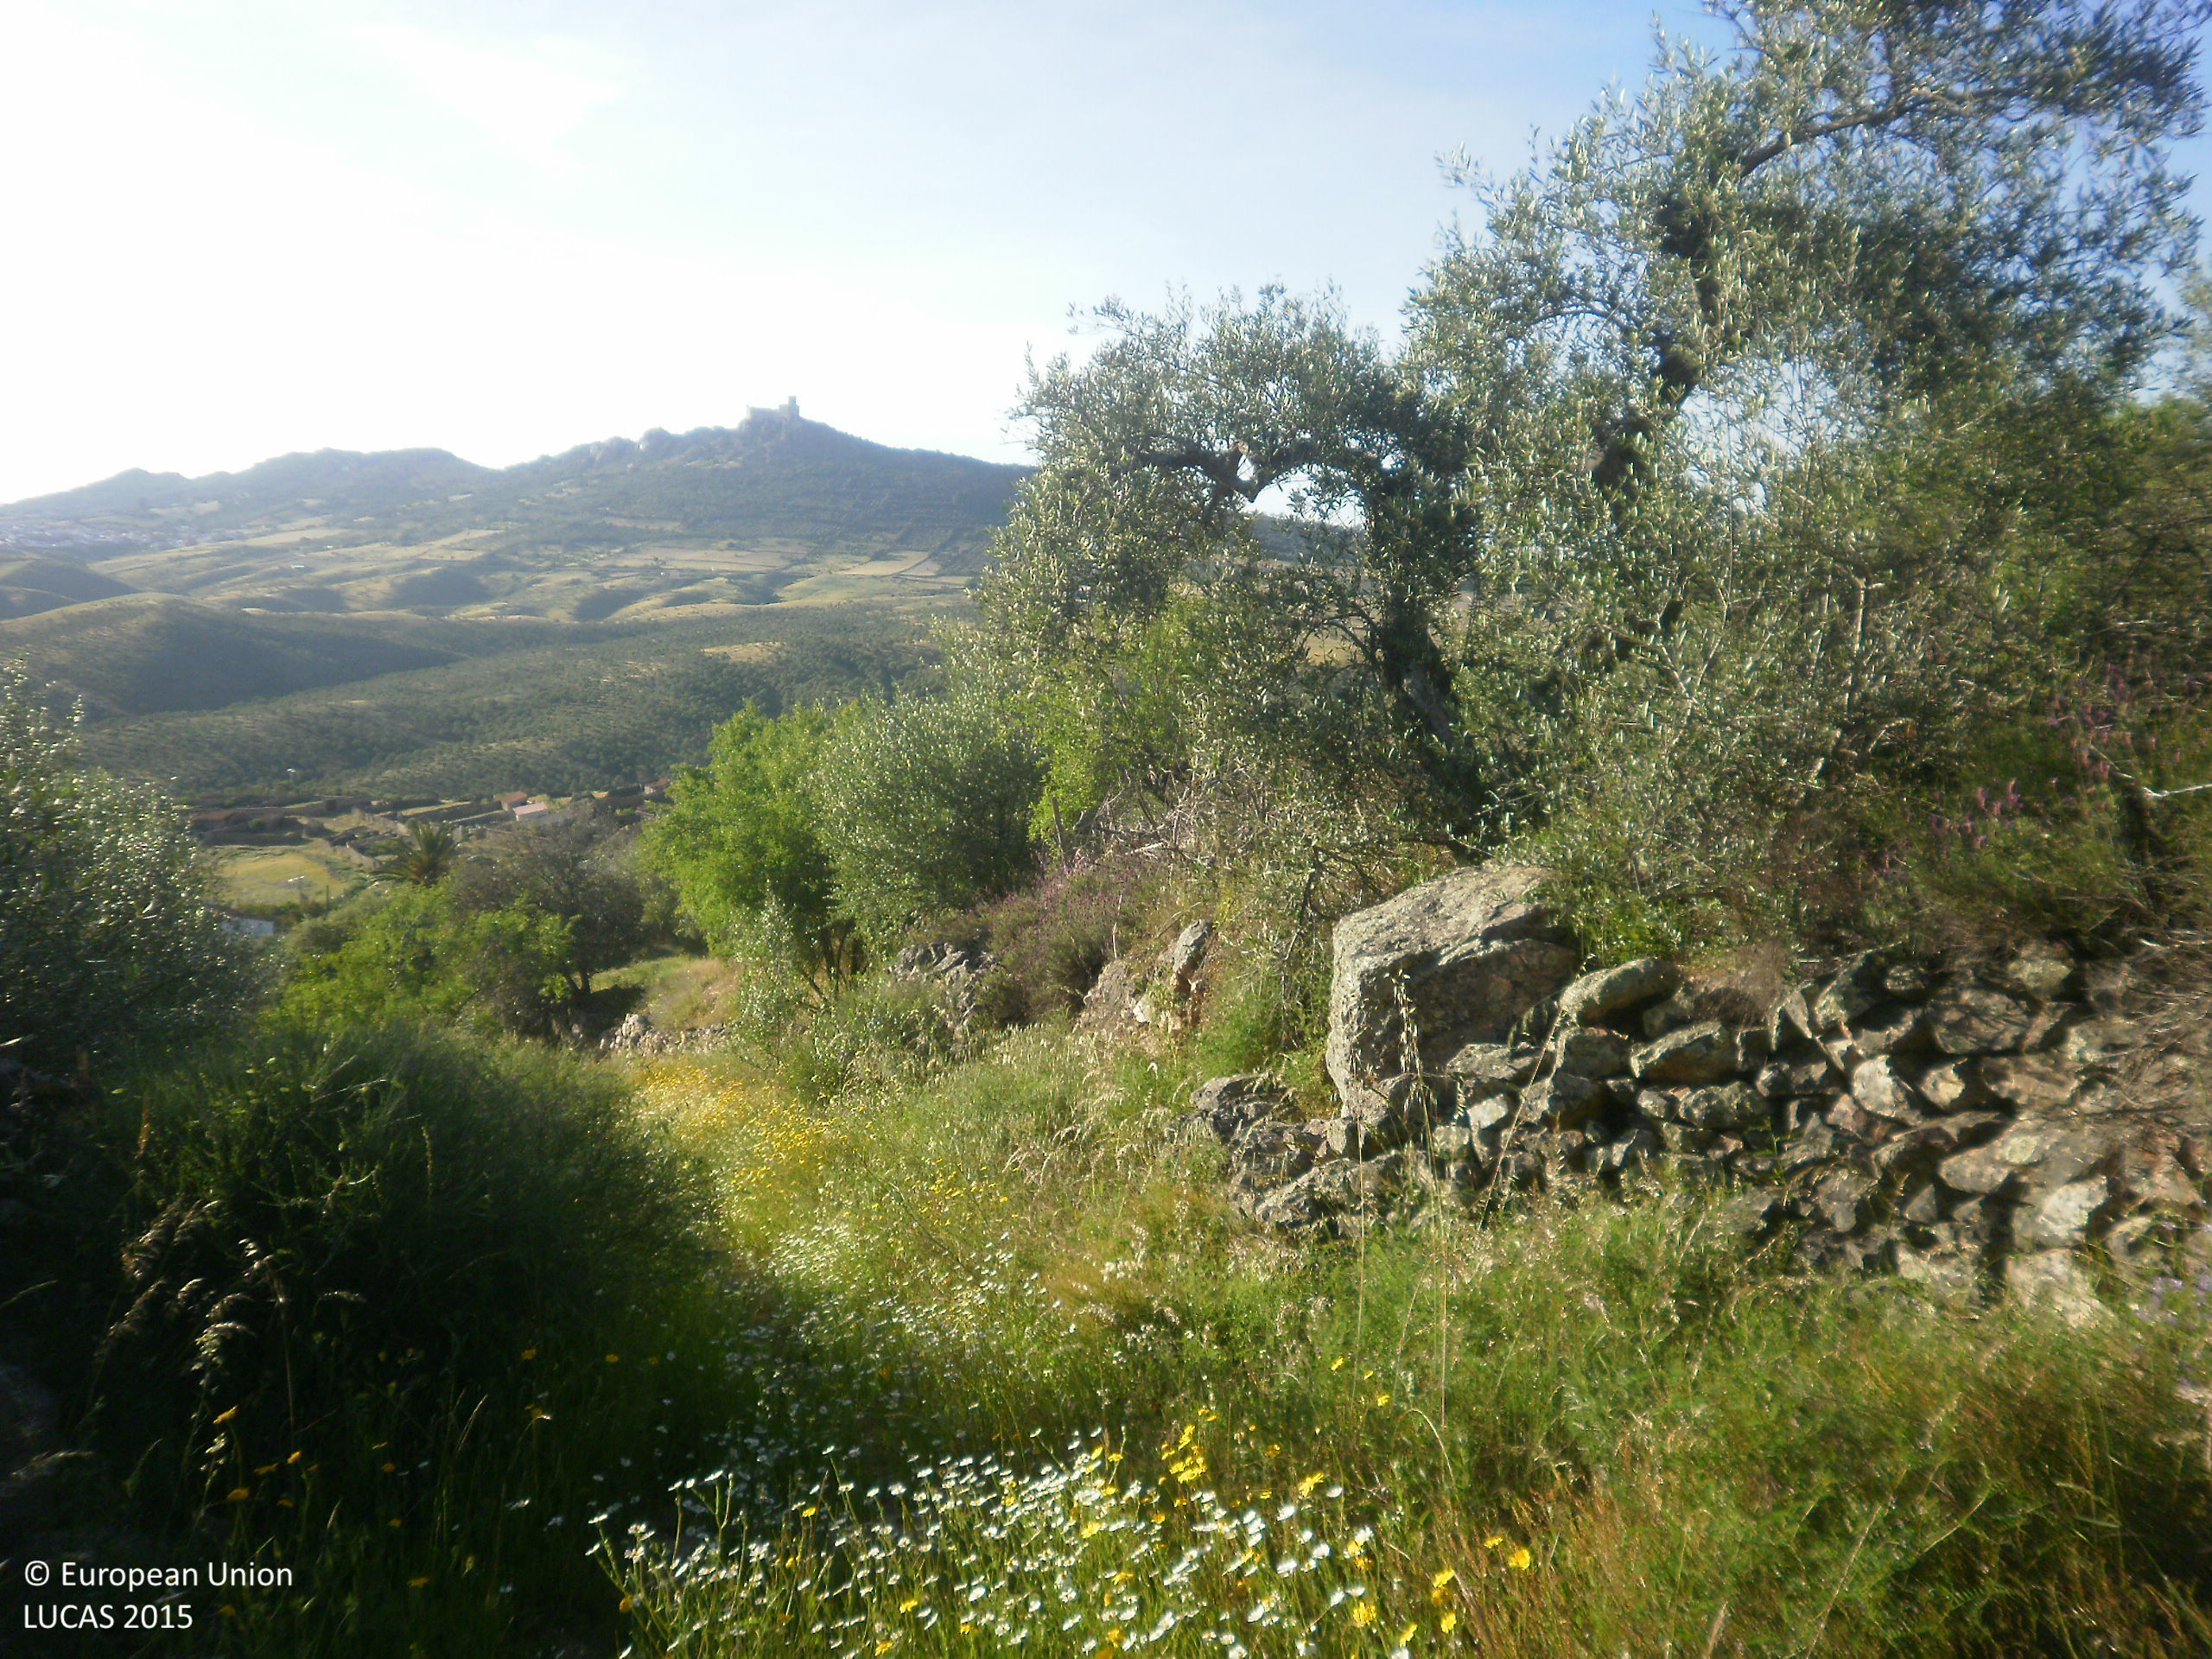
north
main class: Grassland
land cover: Grassland with sparse tree/shrub cover
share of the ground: > 75 %
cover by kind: herbaceous plants 90 %, broadleaved forest trees 5 %, shrubs 5 %
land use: Agriculture (excluding fallow land and kitchen gardens)
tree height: > 5 m
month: April
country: ES
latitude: 38.9591
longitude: -5.2370
